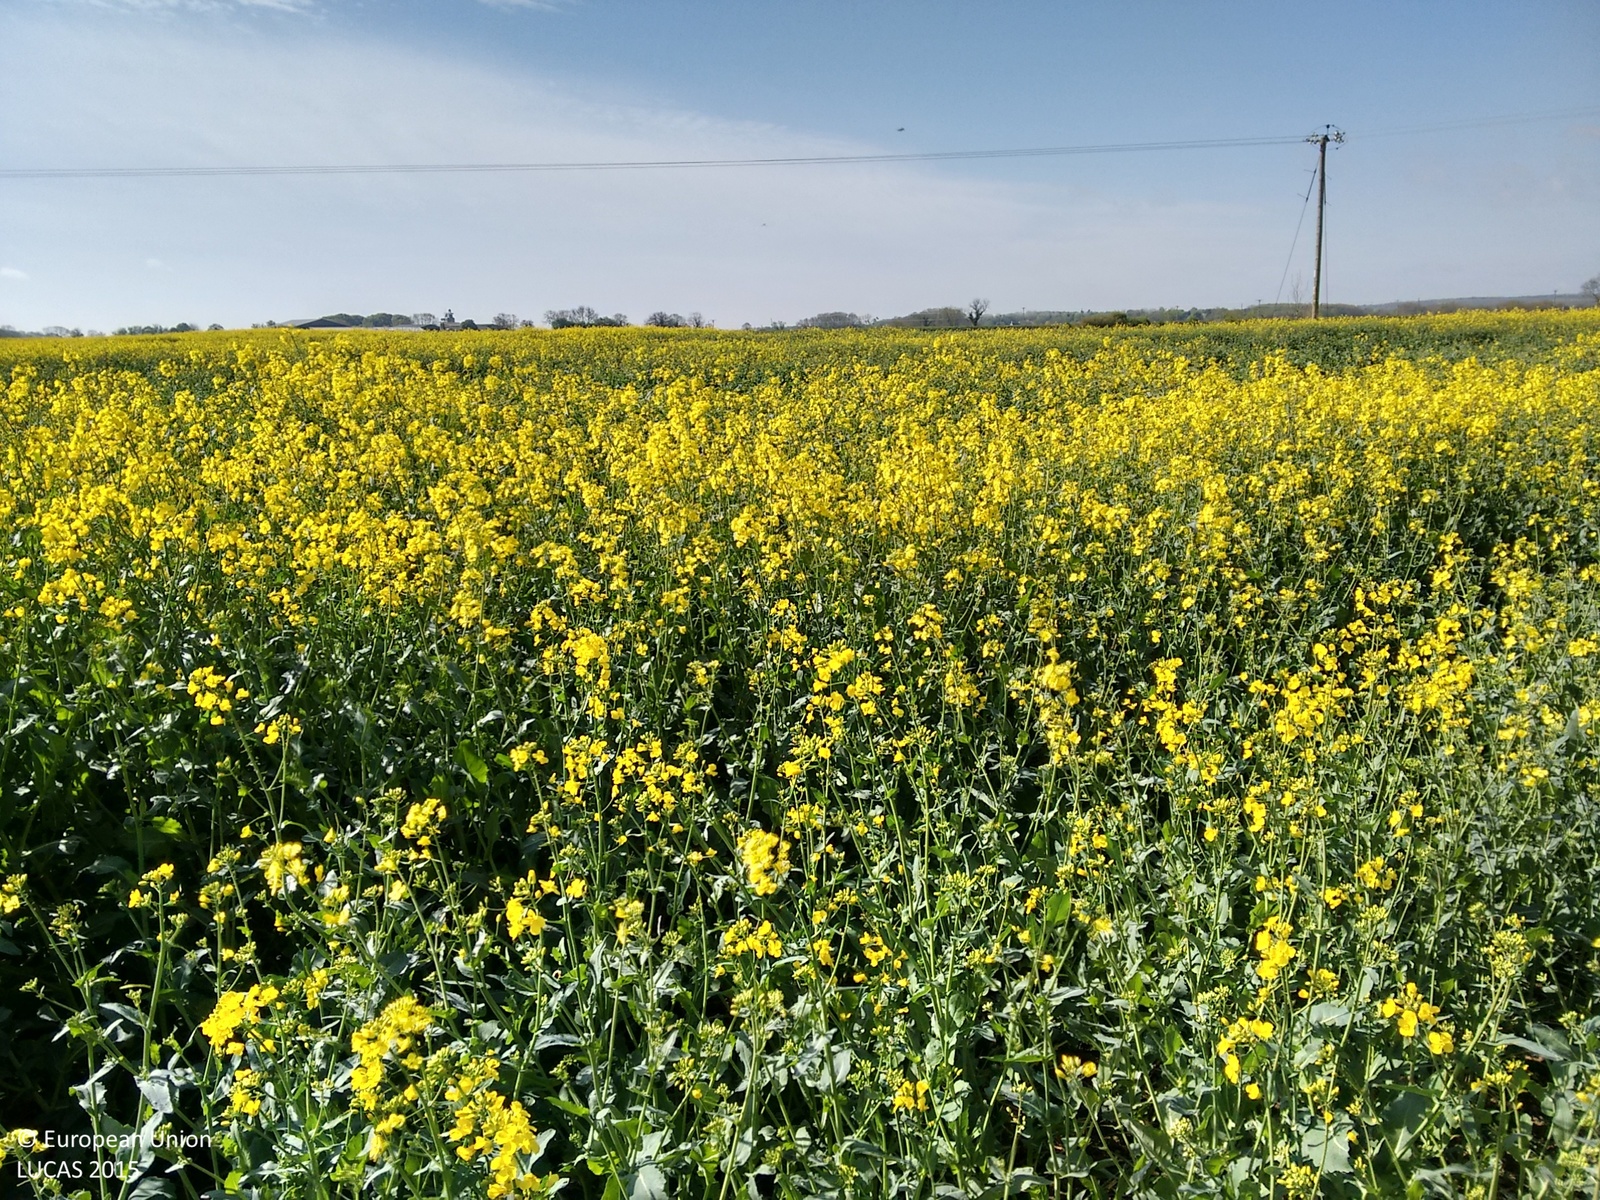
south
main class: Cropland
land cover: Rape and turnip rape
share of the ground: > 75 %
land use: Agriculture (excluding fallow land and kitchen gardens)
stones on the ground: < 10 %
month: May
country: GB
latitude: 53.2403
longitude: 0.2157
